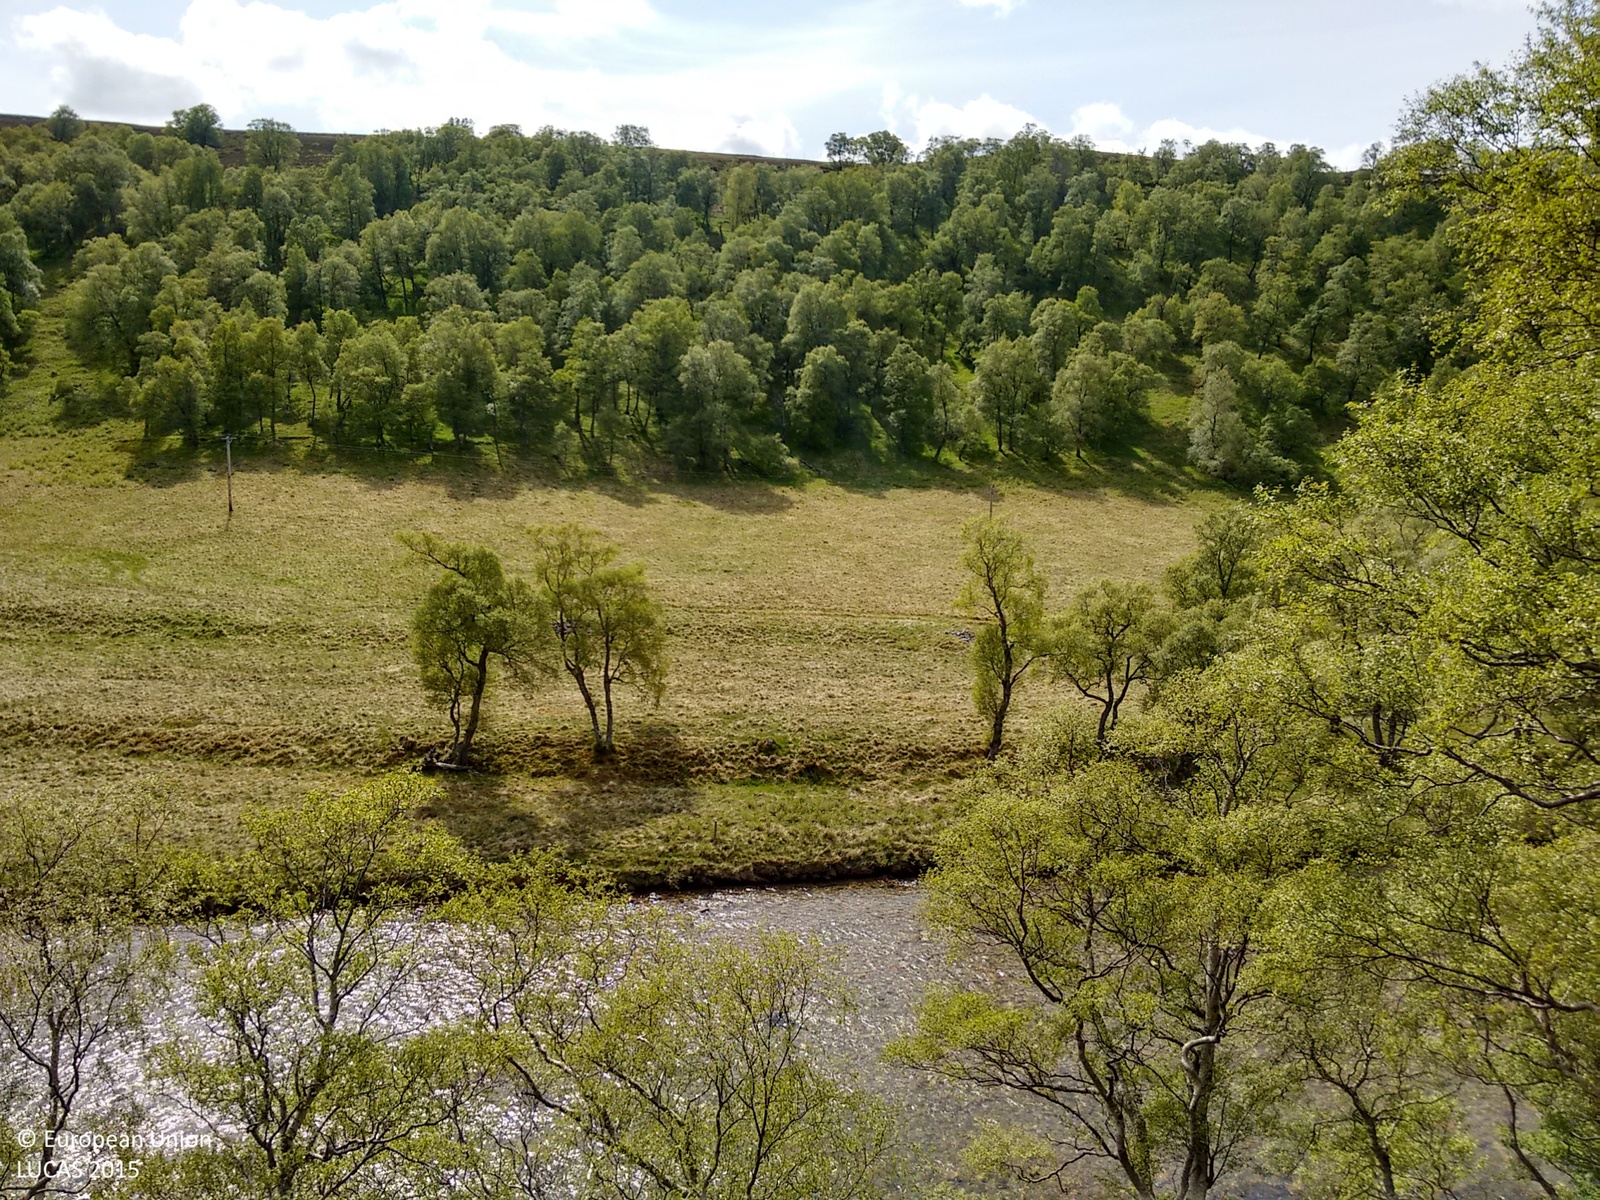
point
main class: Grassland
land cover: Grassland without tree/shrub cover
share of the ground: > 75 %
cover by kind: herbaceous plants 100 %
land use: Agriculture (excluding fallow land and kitchen gardens)
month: June
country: GB
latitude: 57.1979
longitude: -3.3931
